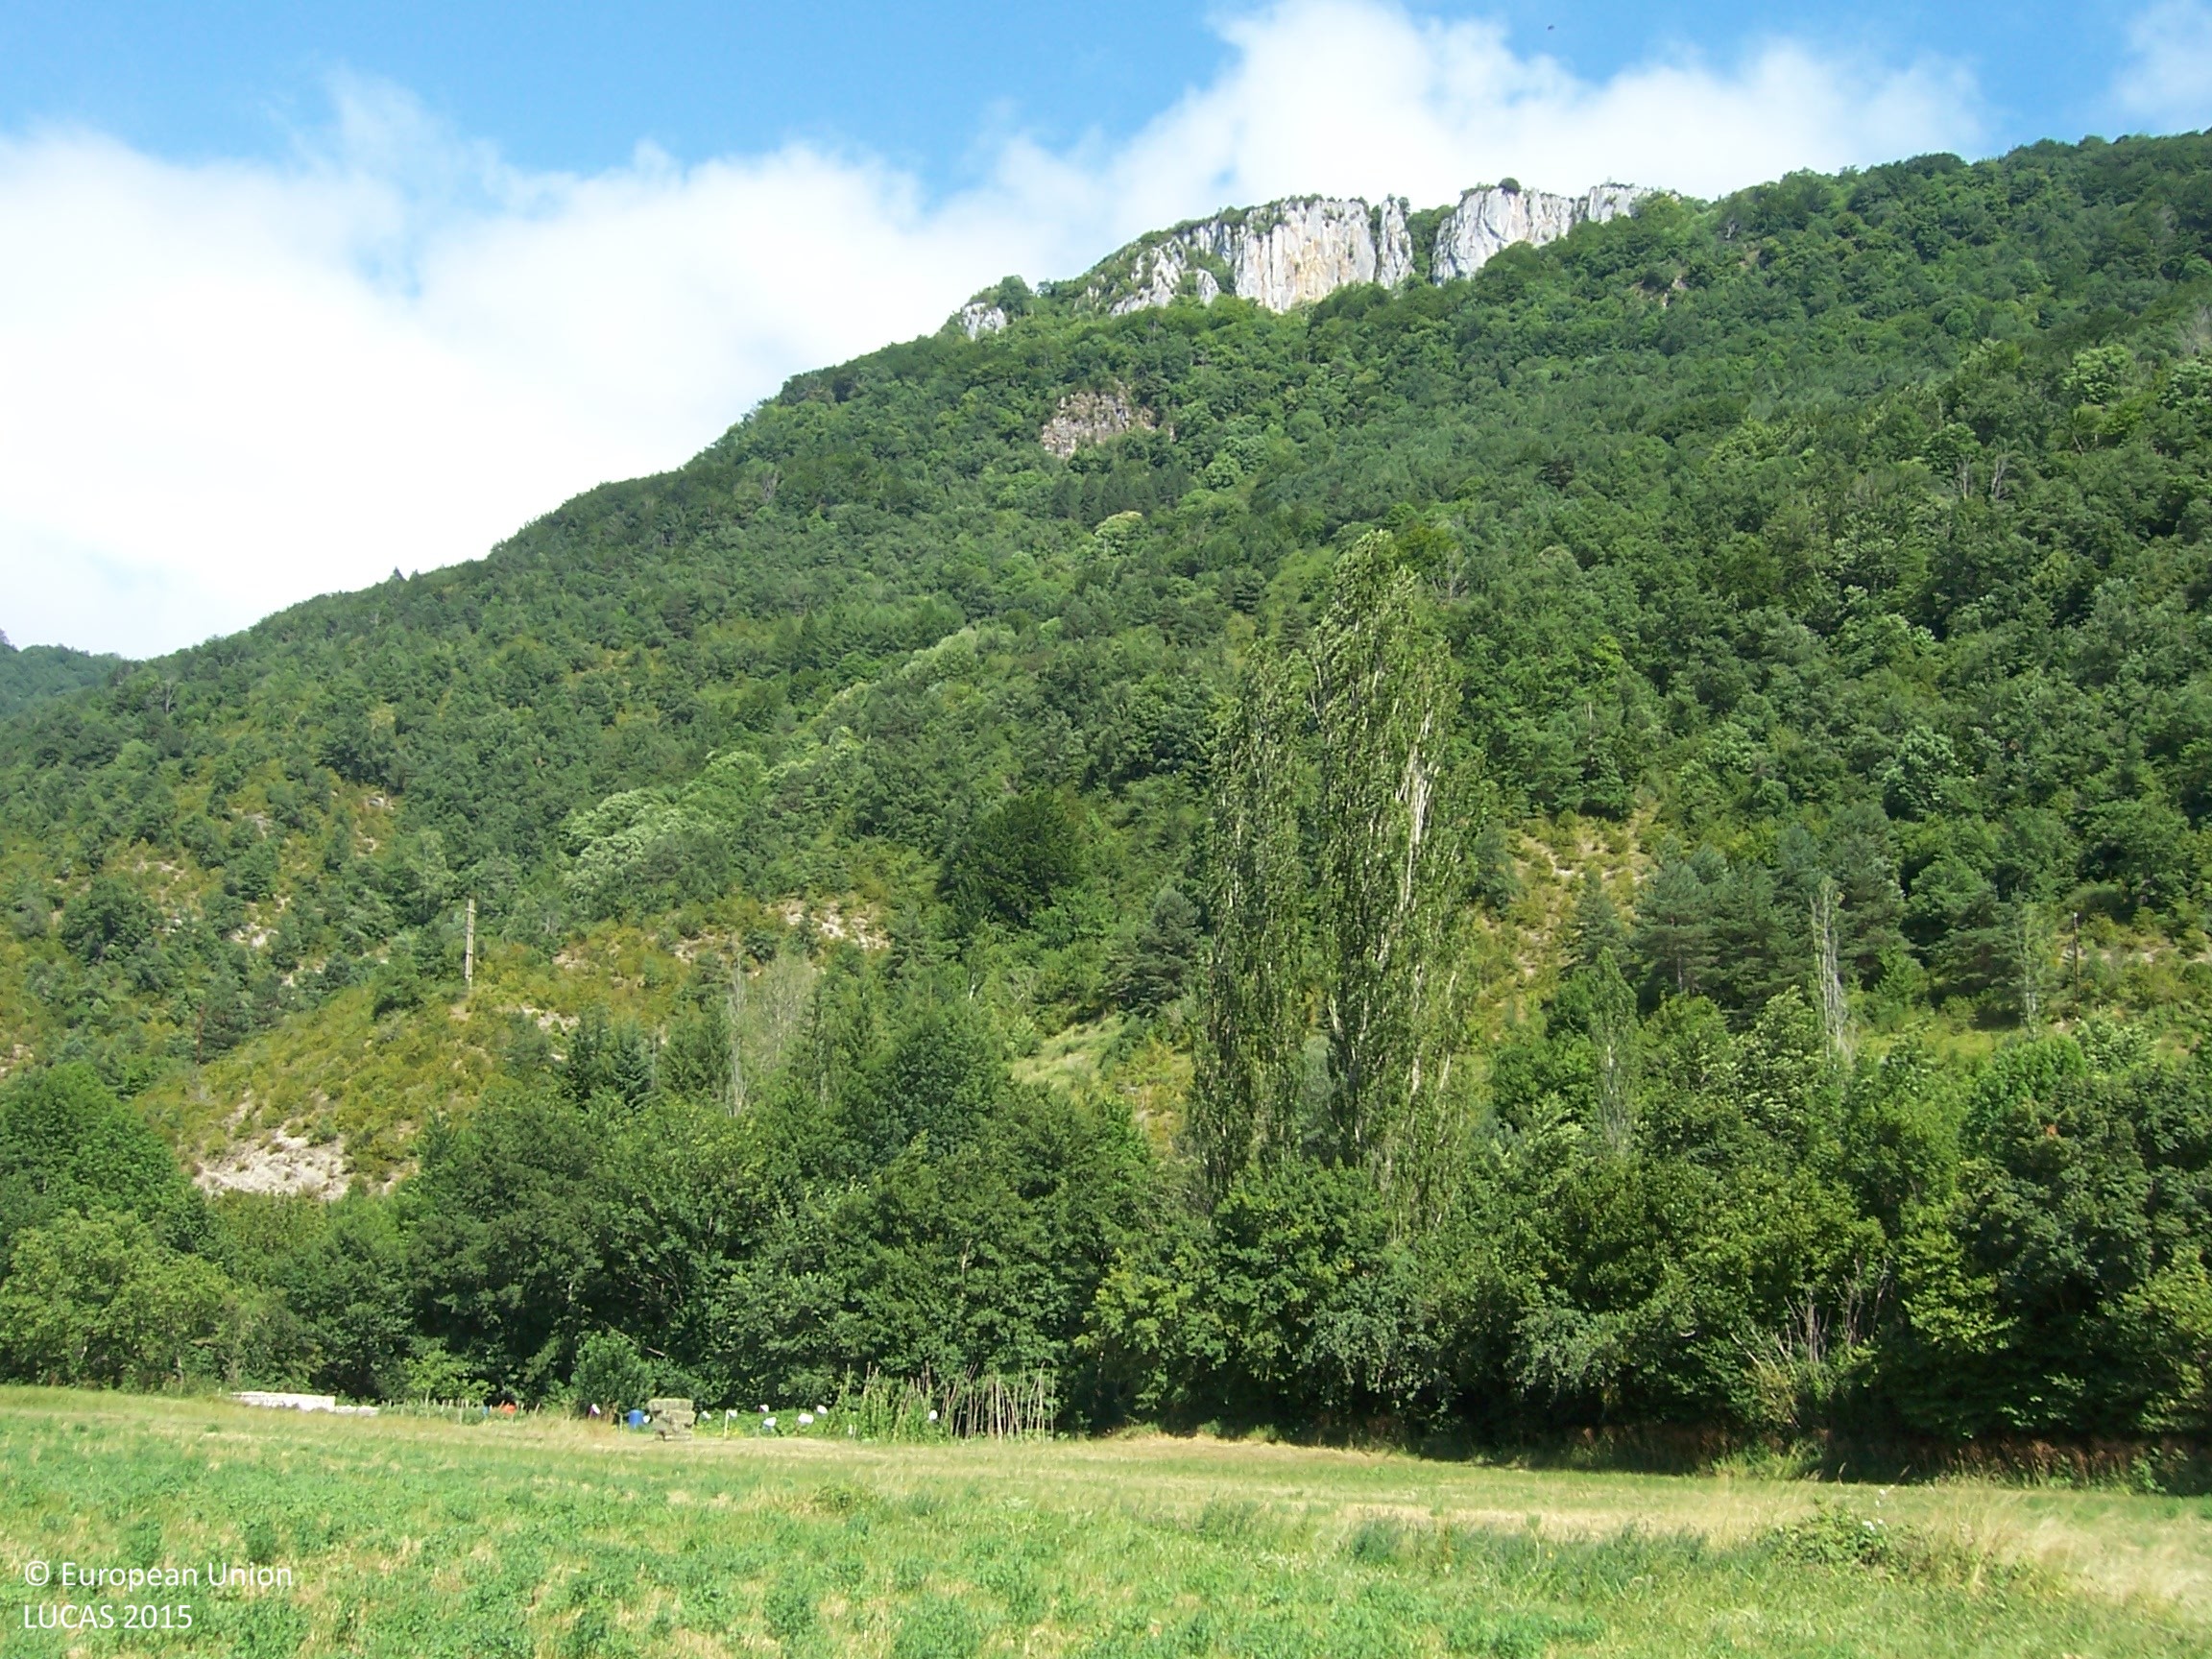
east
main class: Woodland
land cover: Pine dominated mixed woodland
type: coniferous forest of the mediterranean region
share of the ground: > 75 %
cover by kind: coniferous forest trees 75 %, broadleaved forest trees 25 %
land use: Forestry
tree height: > 5 m
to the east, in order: Pine dominated mixed woodland
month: July
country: ES
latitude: 42.8950
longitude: -1.2902
